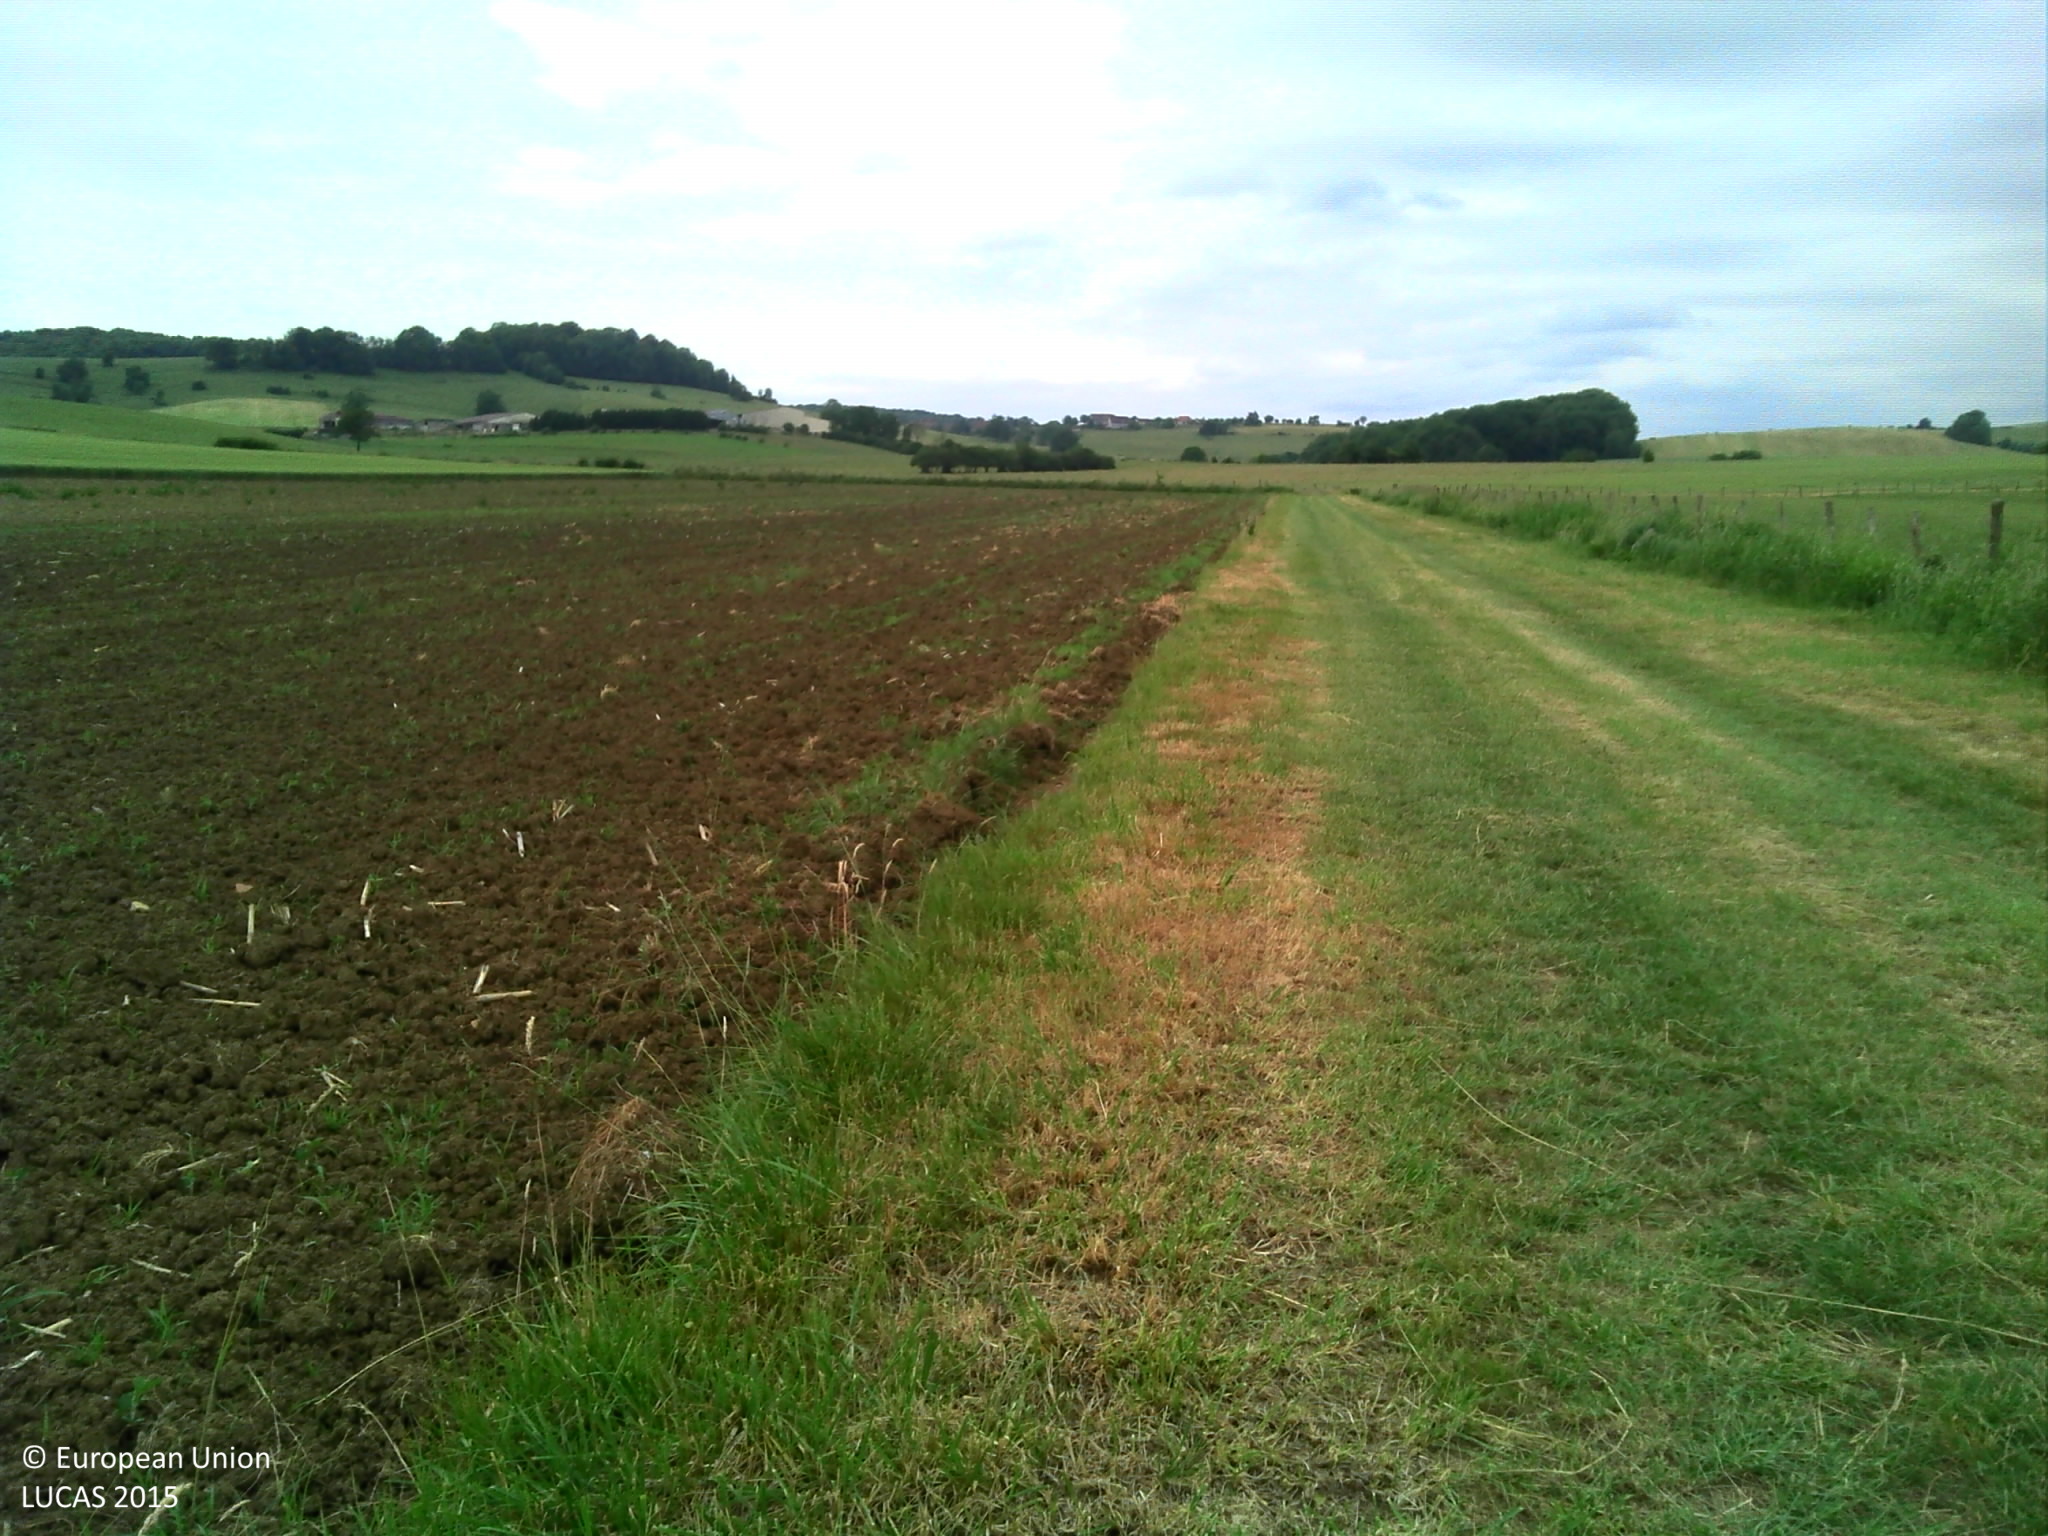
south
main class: Grassland
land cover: Grassland without tree/shrub cover
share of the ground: > 75 %
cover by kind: herbaceous plants 100 %
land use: Agriculture (excluding fallow land and kitchen gardens)
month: June
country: FR
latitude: 47.6233
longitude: 6.3688
